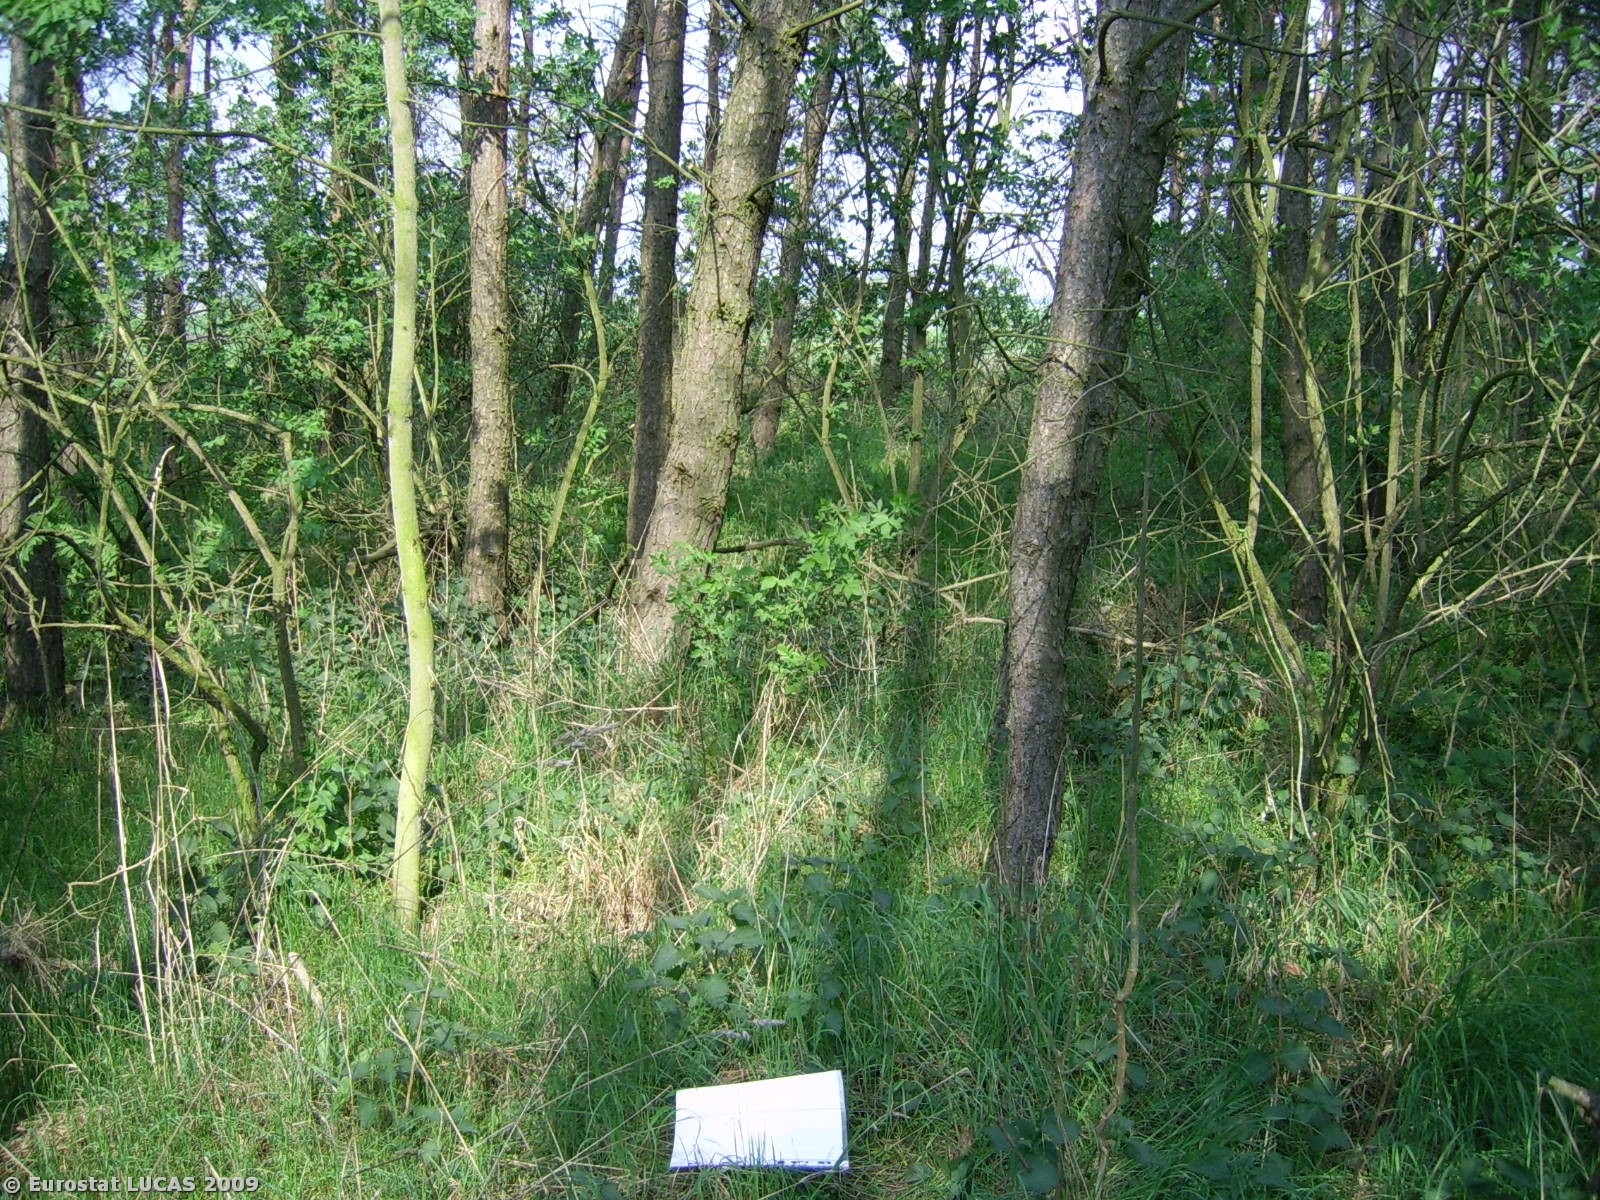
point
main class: Woodland
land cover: Coniferous woodland
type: hemiboreal forest and nemoral coniferous forest and mixed broadleaved-coniferous forest
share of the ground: > 75 %
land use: Forestry
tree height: > 5 m
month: April
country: PL
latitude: 51.9785
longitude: 16.8958
